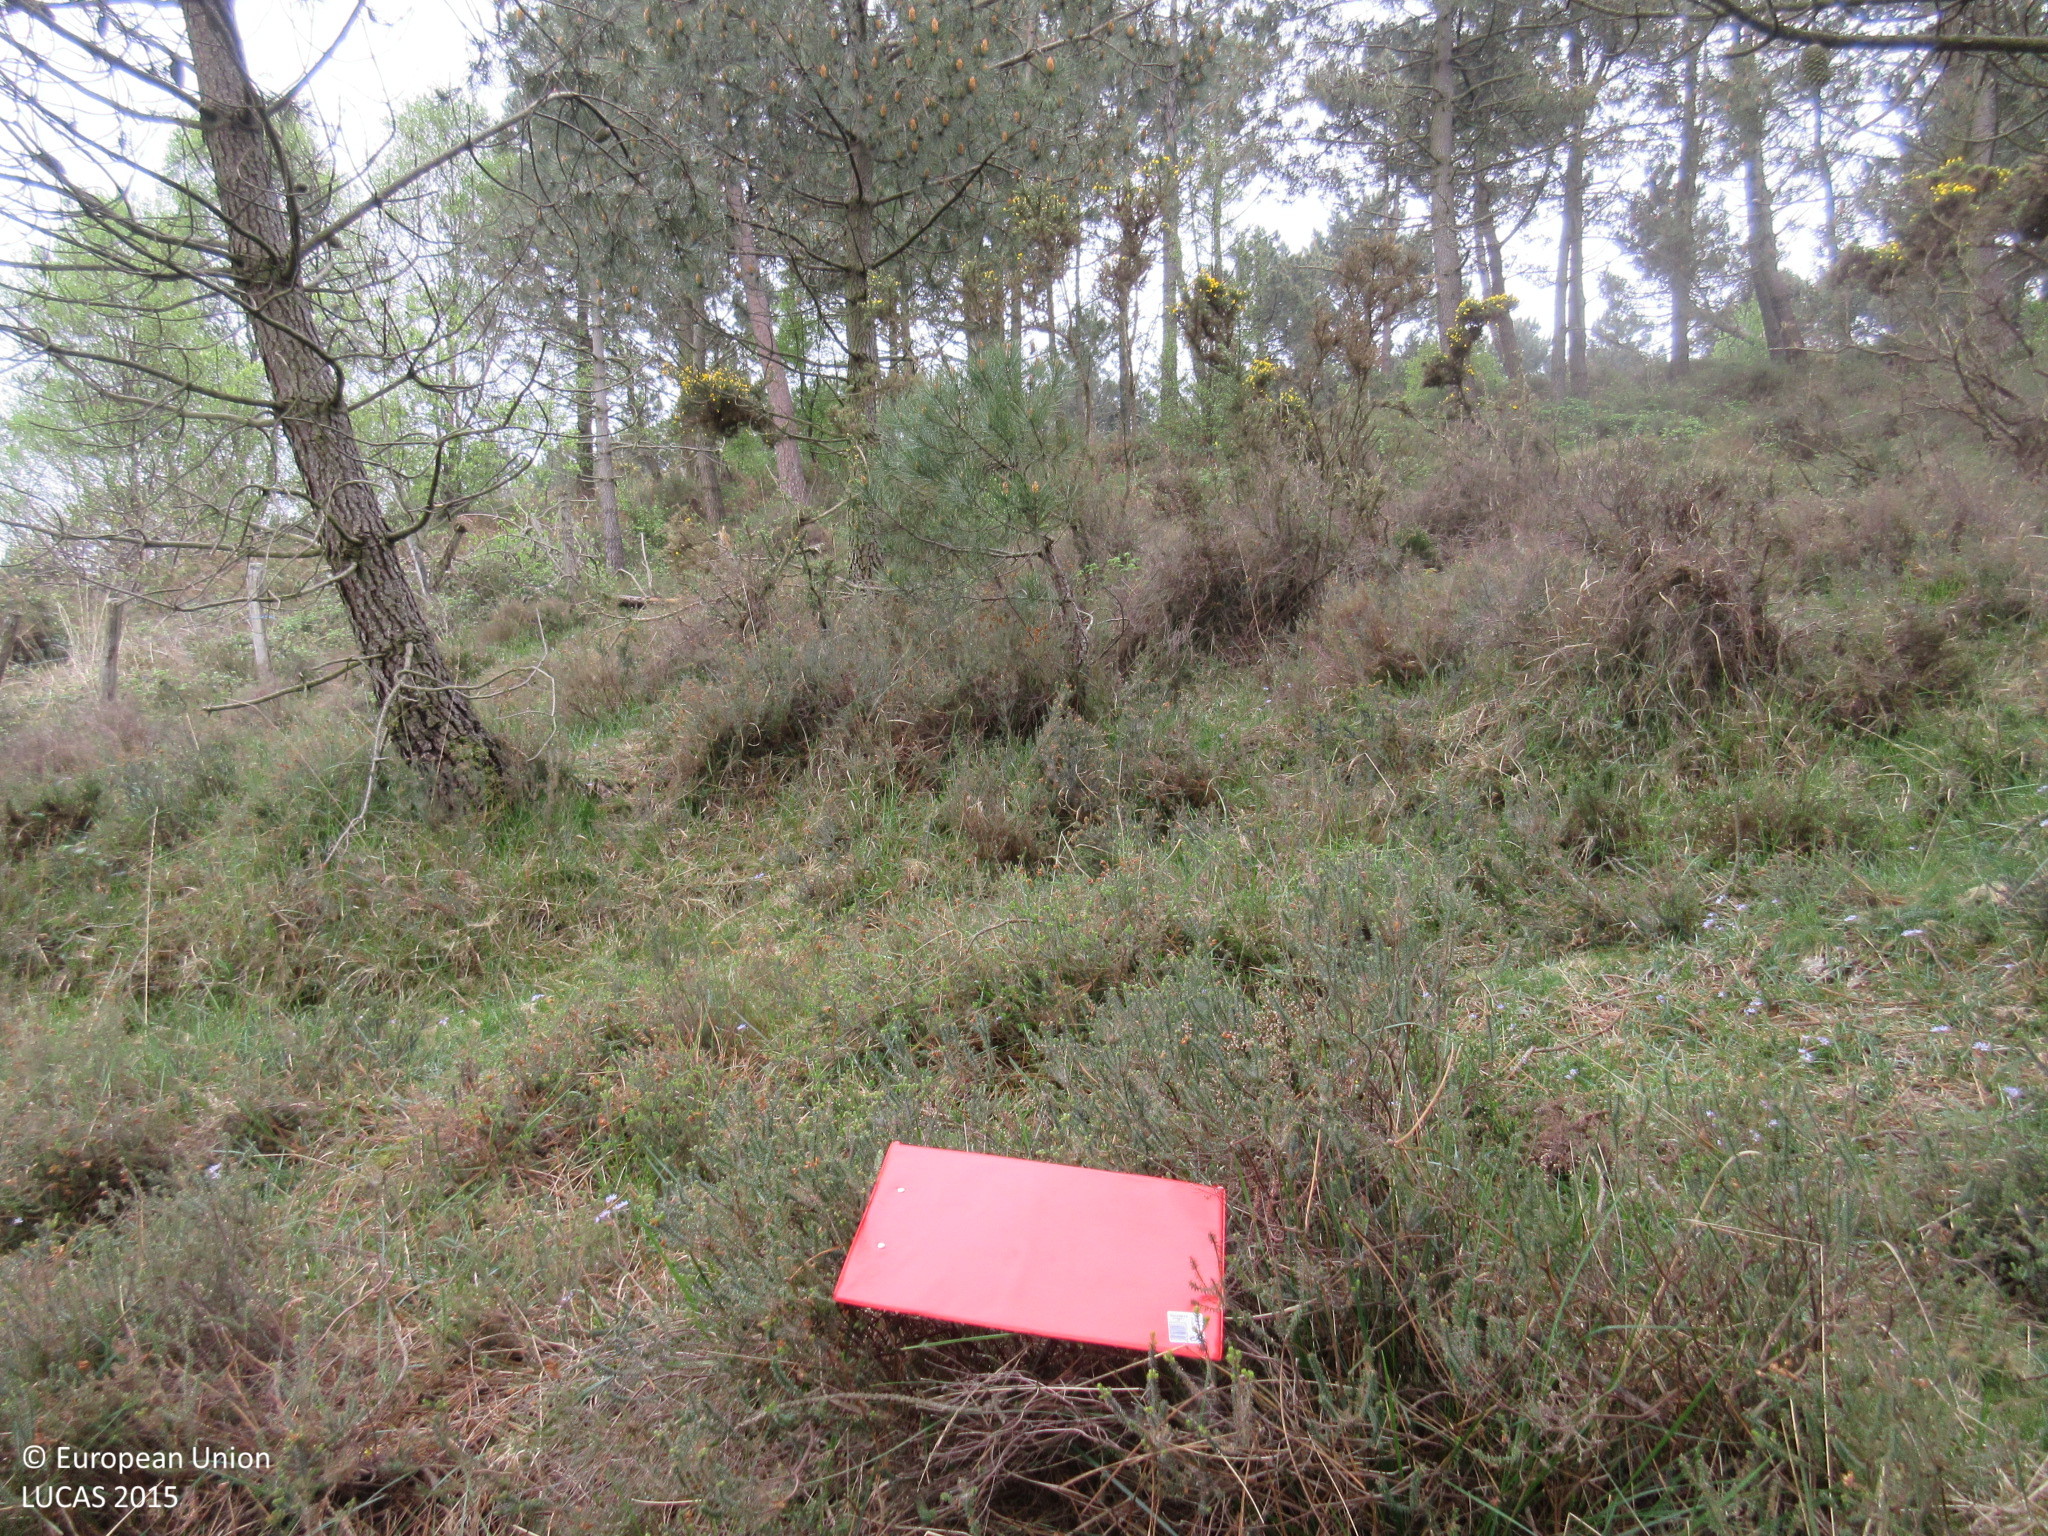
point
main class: Woodland
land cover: Pine dominated coniferous woodland
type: hemiboreal forest and nemoral coniferous forest and mixed broadleaved-coniferous forest
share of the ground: 50 - 75 %
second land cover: Shrubland without tree cover
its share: > 75 %
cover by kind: coniferous forest trees 70 %, shrubs 30 %
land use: Forestry
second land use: Agriculture (excluding fallow land and kitchen gardens)
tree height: > 5 m
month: April
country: ES
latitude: 43.4894
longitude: -6.7673
